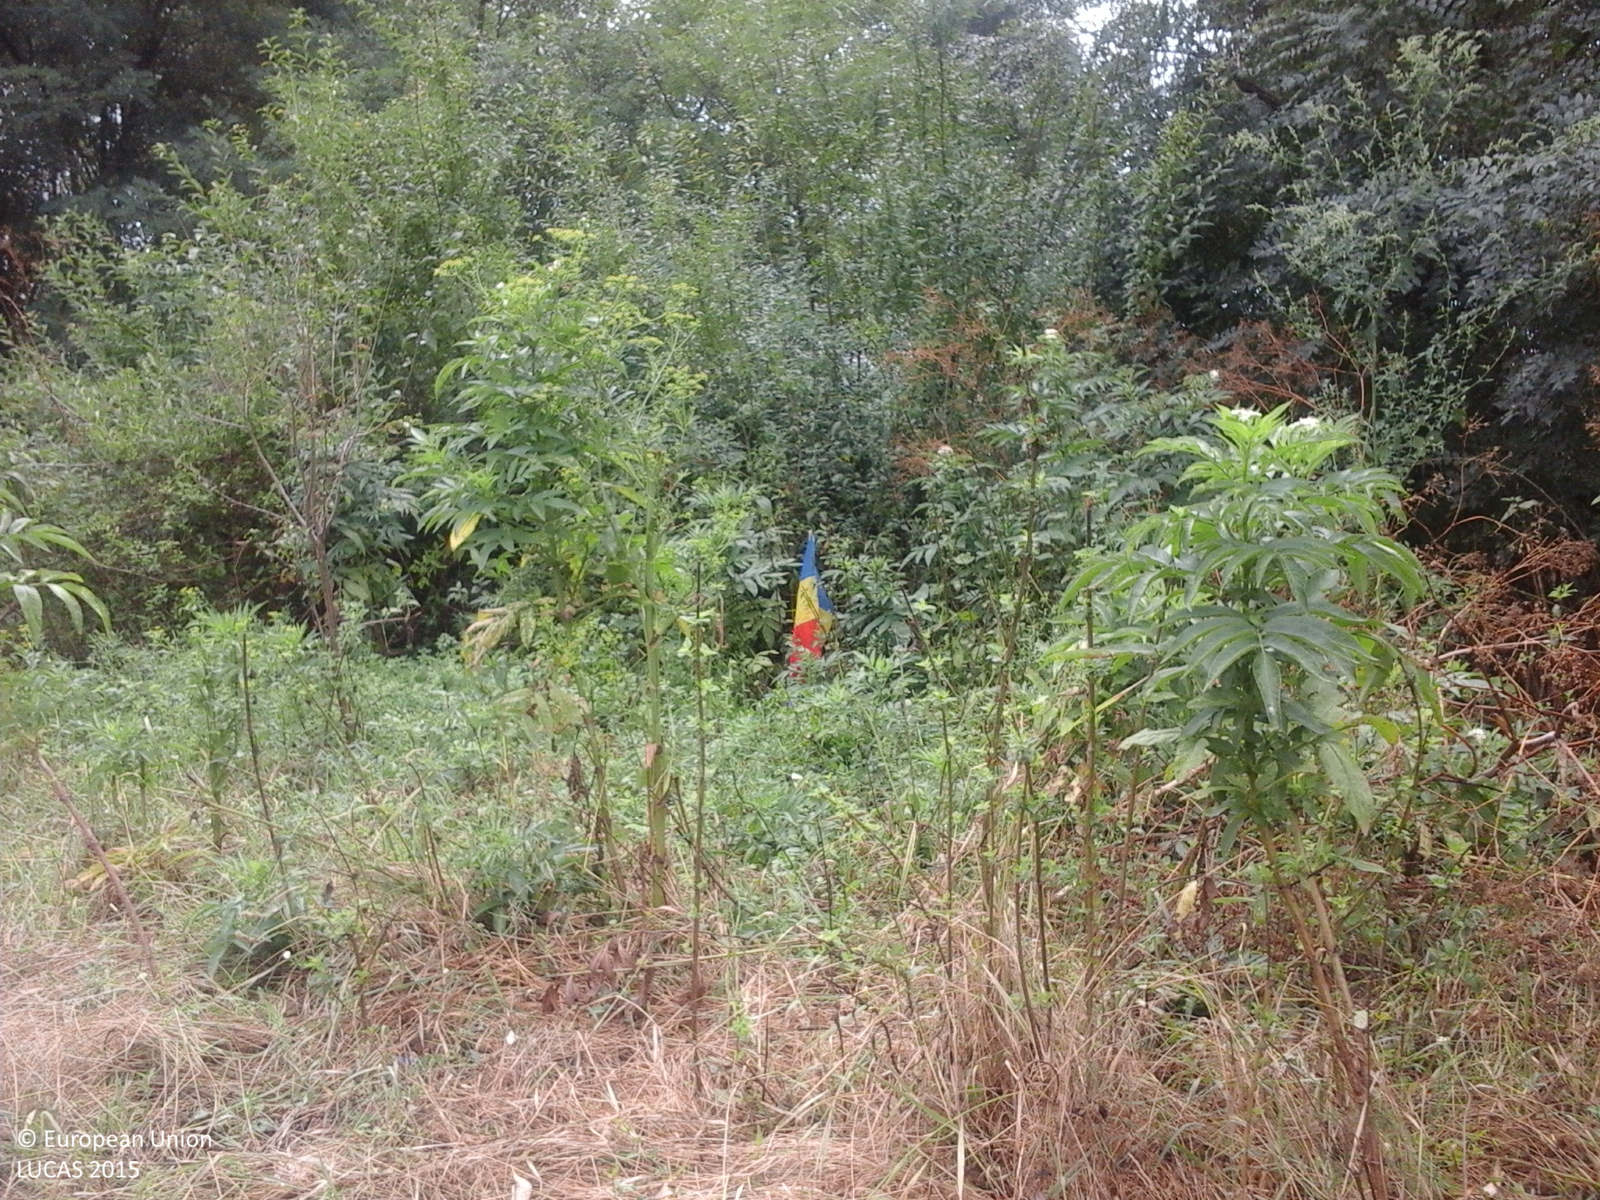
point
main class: Grassland
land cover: Spontaneously vegetated surfaces
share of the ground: > 75 %
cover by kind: herbaceous plants 100 %
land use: Fallow land
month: August
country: RO
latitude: 45.7110
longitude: 21.6608
